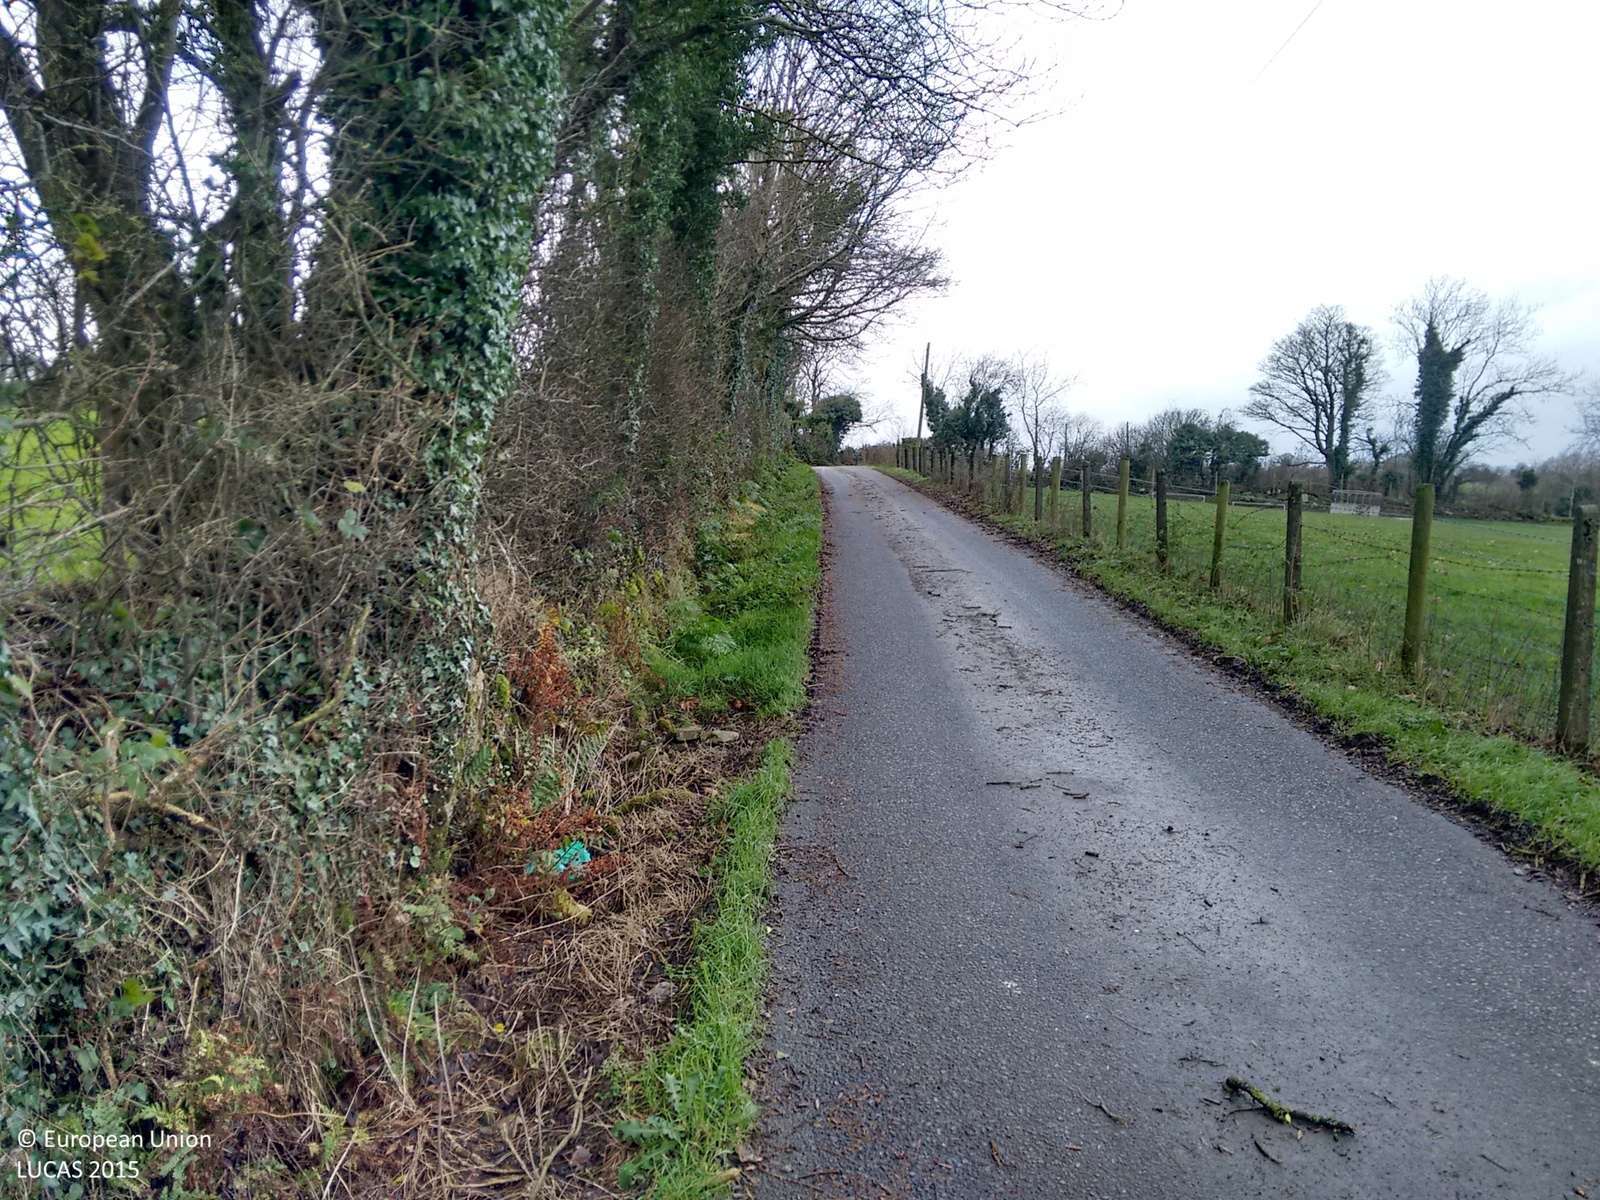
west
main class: Grassland
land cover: Grassland without tree/shrub cover
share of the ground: > 75 %
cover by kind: herbaceous plants 100 %
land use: Agriculture (excluding fallow land and kitchen gardens)
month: December
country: IE
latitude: 54.0992
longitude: -6.8817
